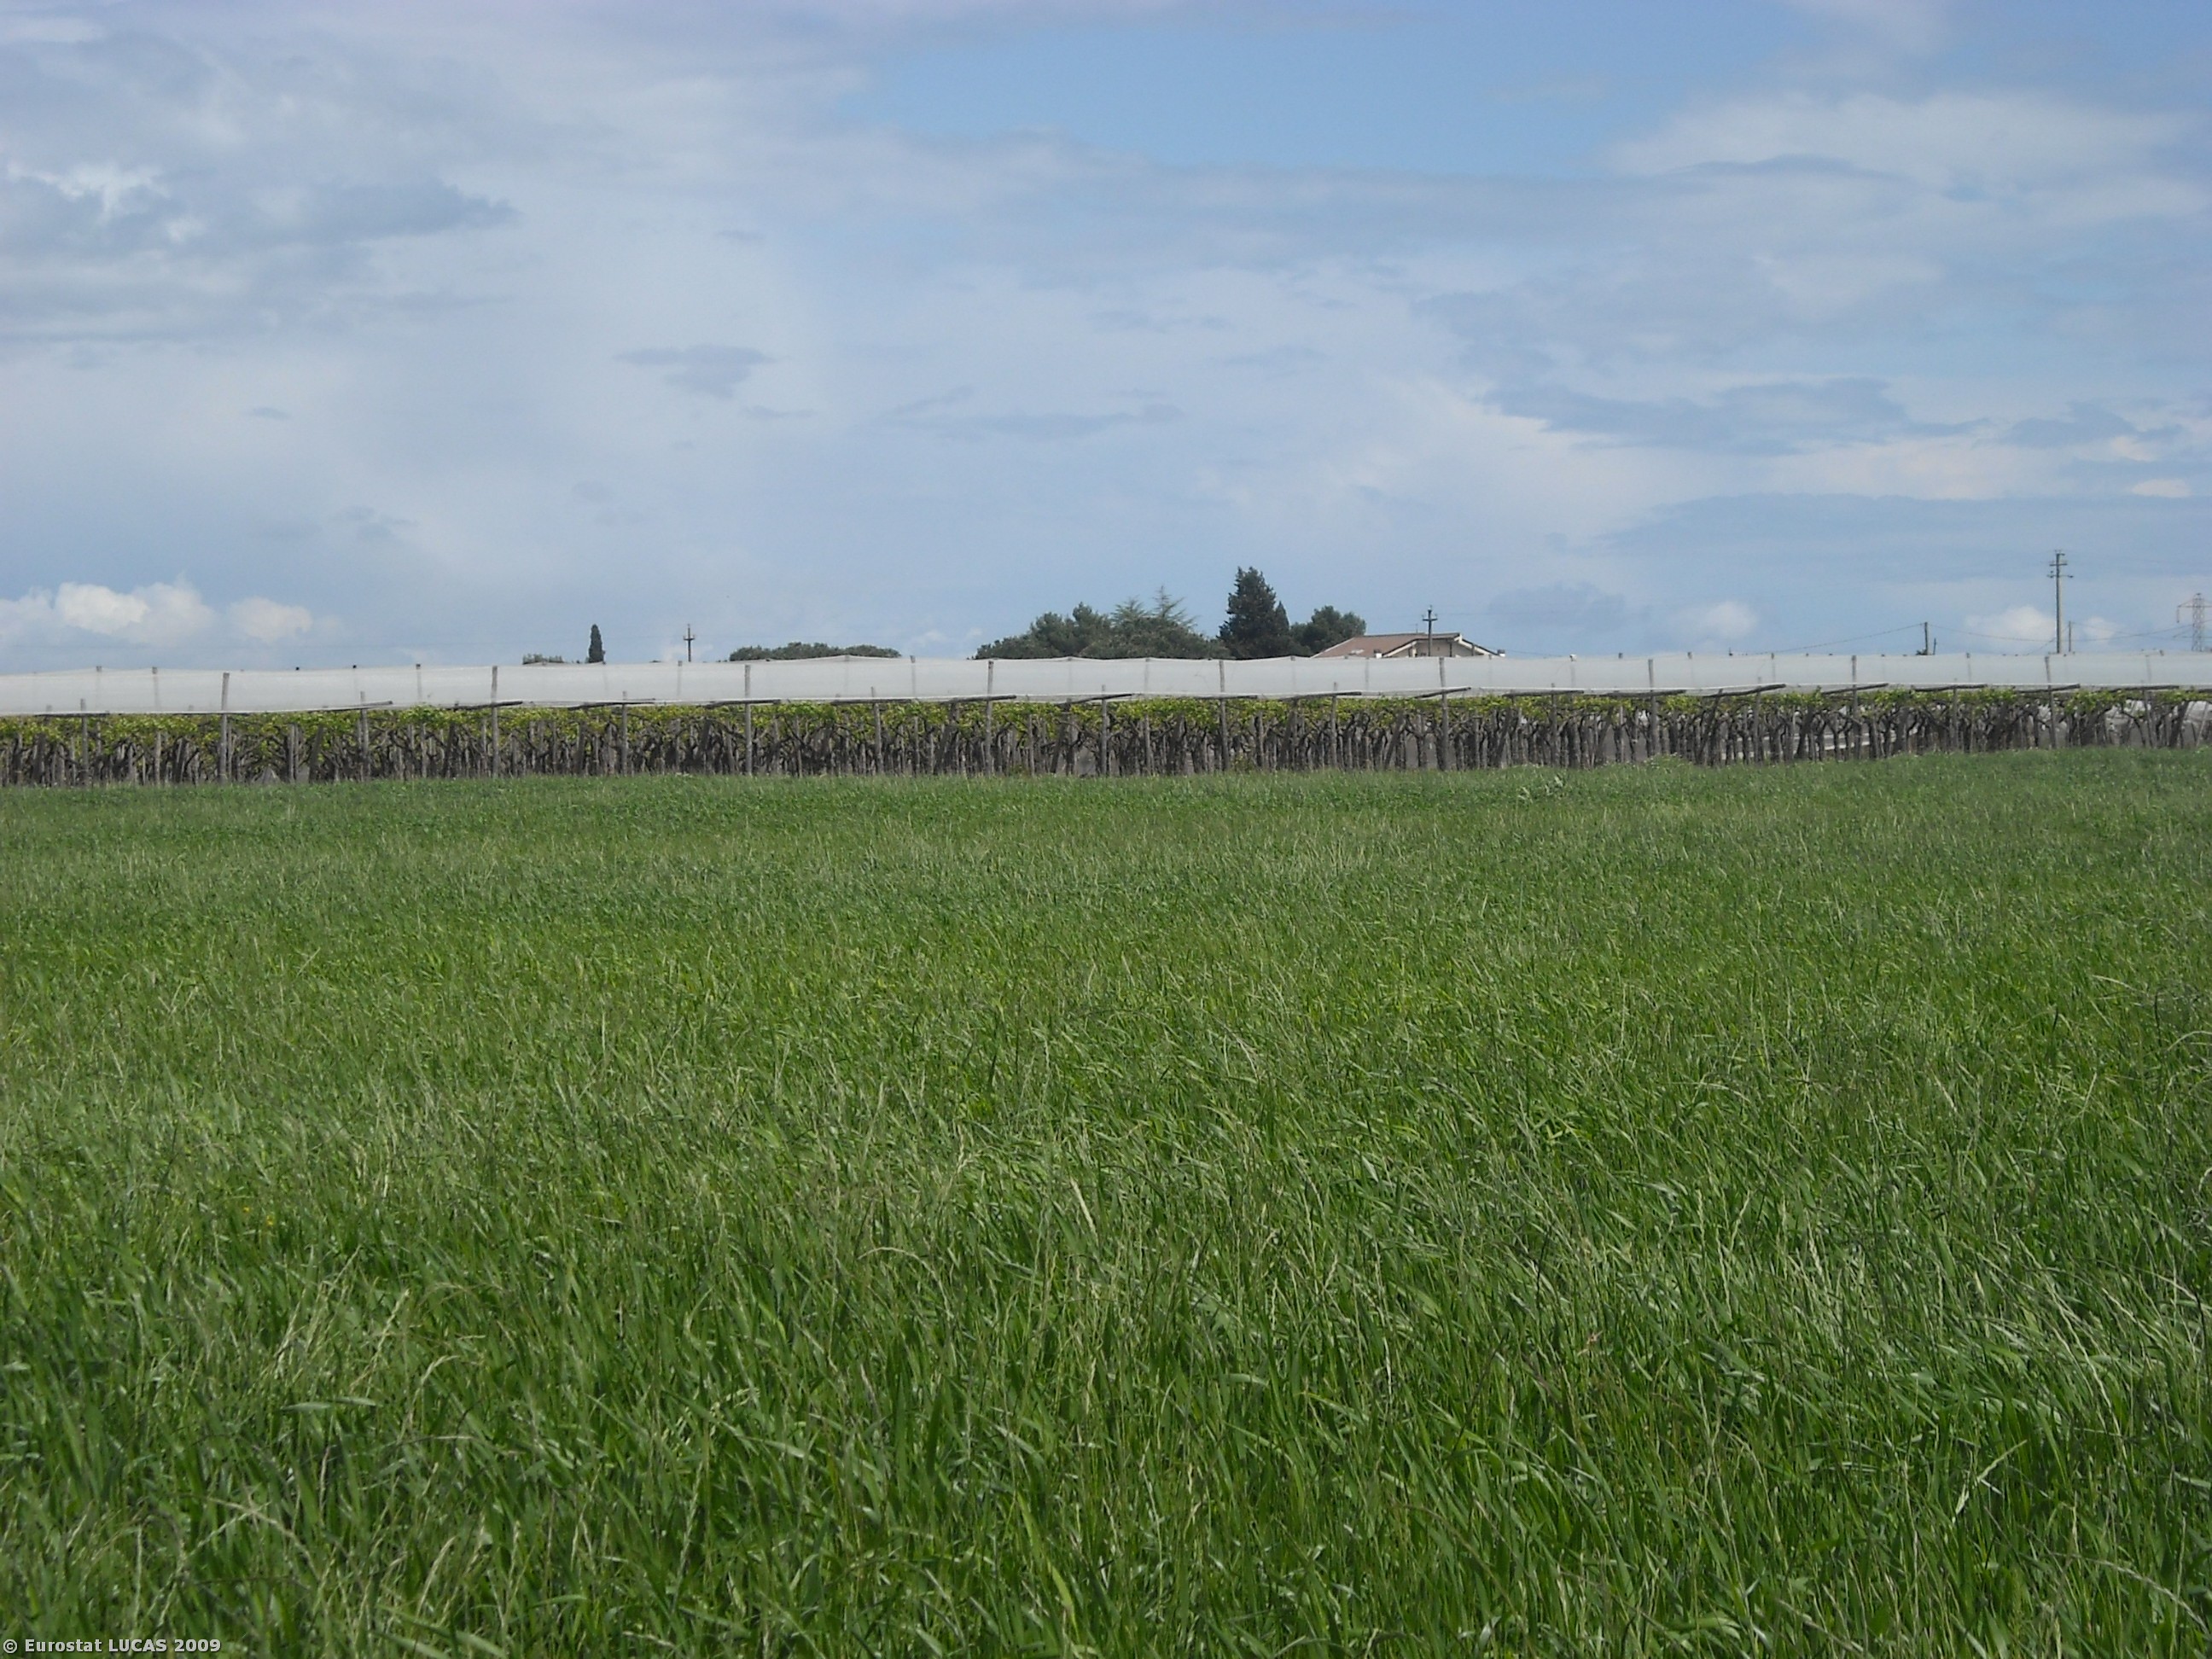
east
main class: Cropland
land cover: Durum wheat
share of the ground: > 75 %
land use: Agriculture (excluding fallow land and kitchen gardens)
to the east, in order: Durum wheat; Paved roads, cycling and walking lanes; Bare land; Vineyards; Bare land; Vineyards
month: April
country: IT
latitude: 40.4945
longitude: 16.9252
